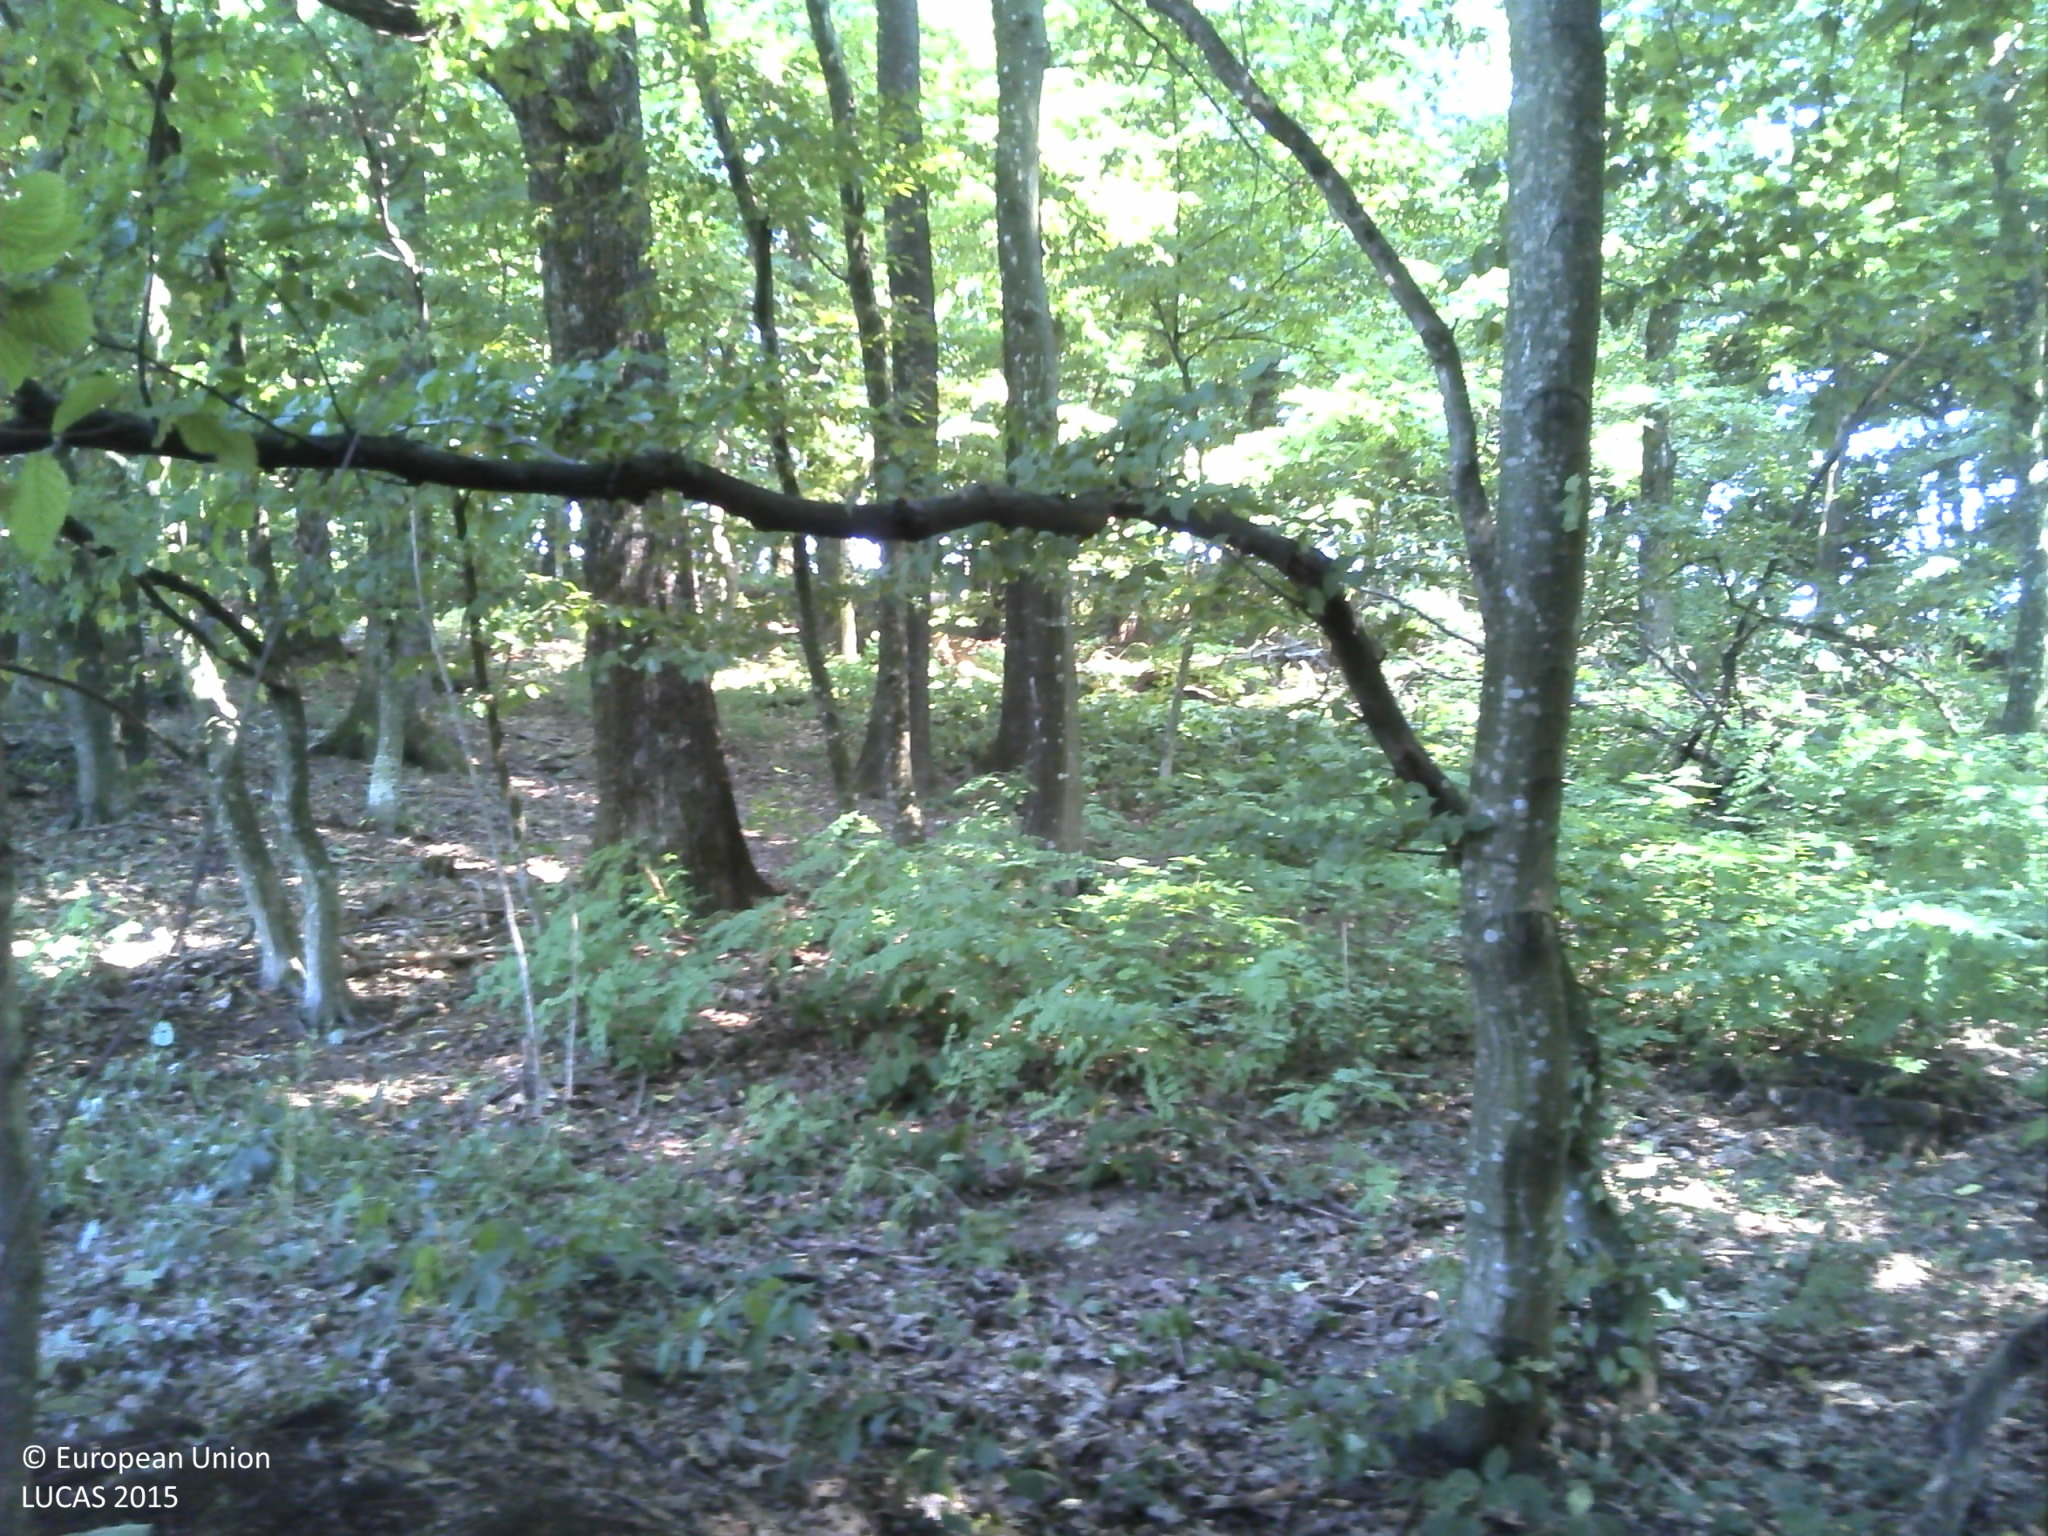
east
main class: Woodland
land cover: Broadleaved woodland
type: mesophytic deciduous forest
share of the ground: > 75 %
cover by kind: broadleaved forest trees 100 %
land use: Forestry
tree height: > 5 m
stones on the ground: < 10 %
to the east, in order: Broadleaved woodland; Tracks; Barley
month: August
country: HR
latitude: 45.7616
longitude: 16.6982
